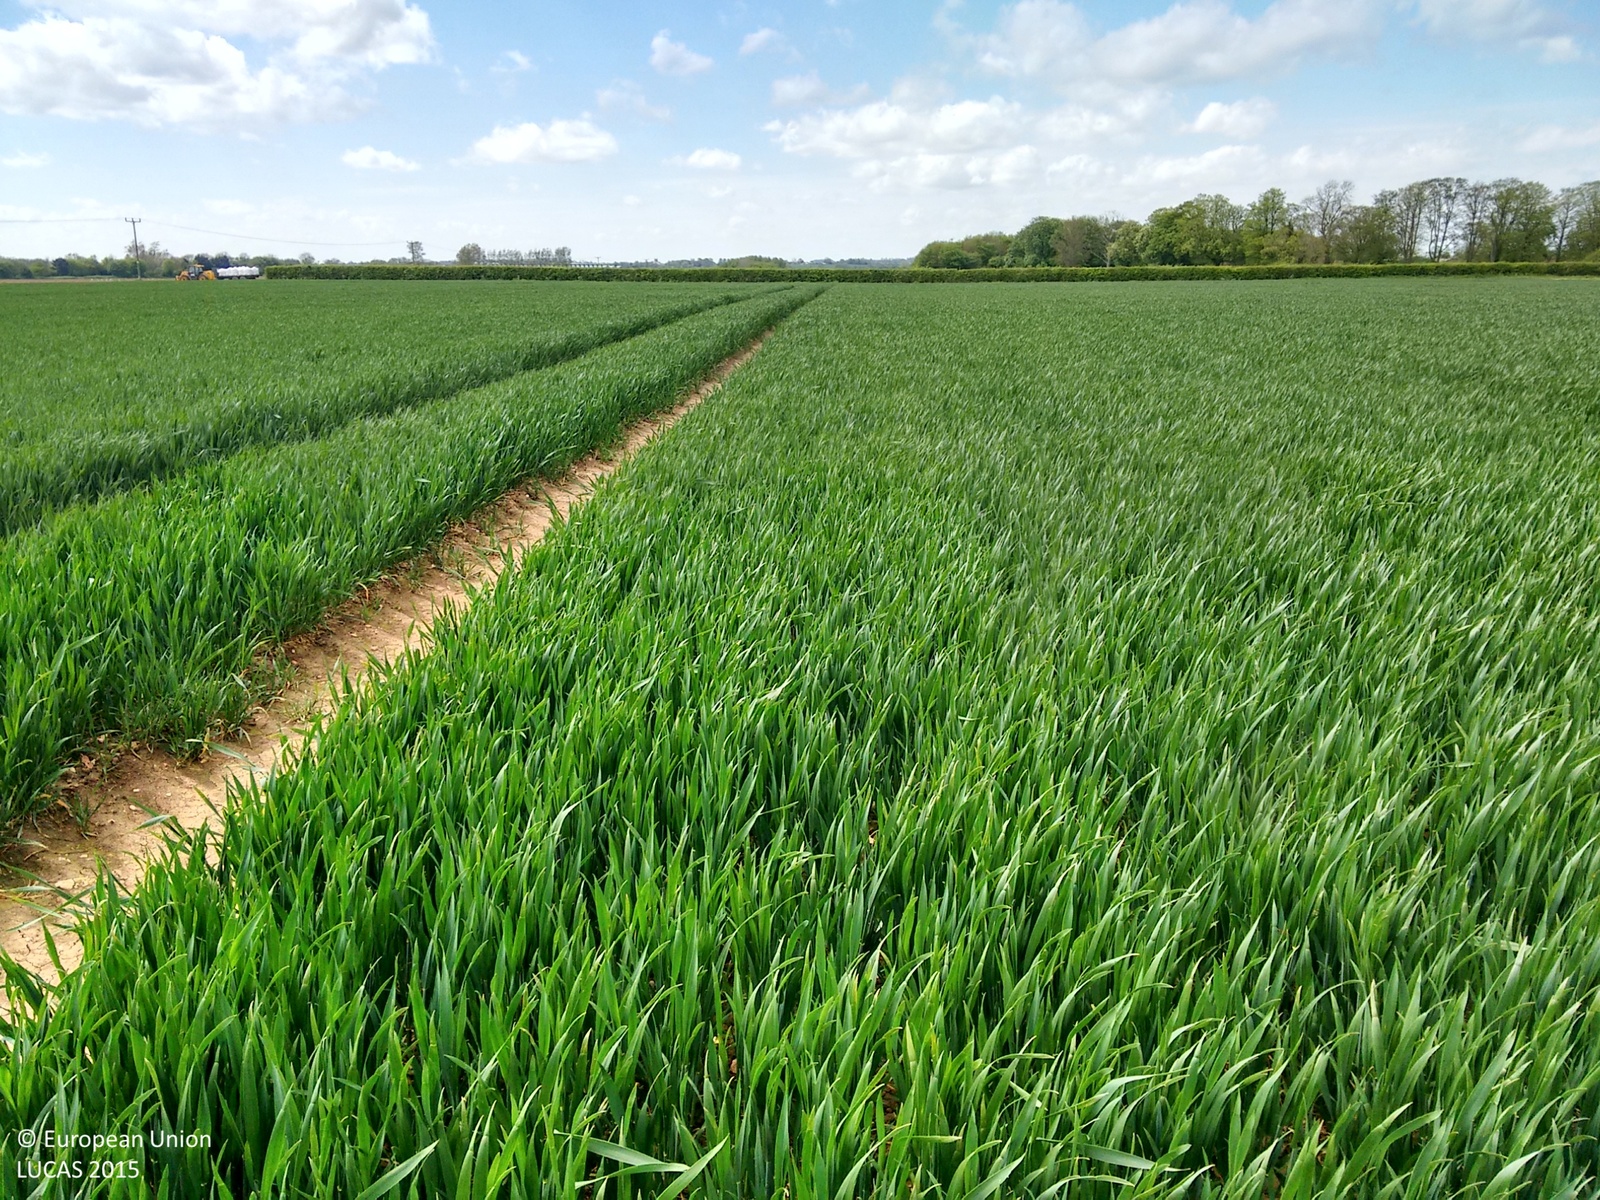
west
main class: Cropland
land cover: Common wheat
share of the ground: > 75 %
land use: Agriculture (excluding fallow land and kitchen gardens)
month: May
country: GB
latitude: 53.1643
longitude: 0.1726
